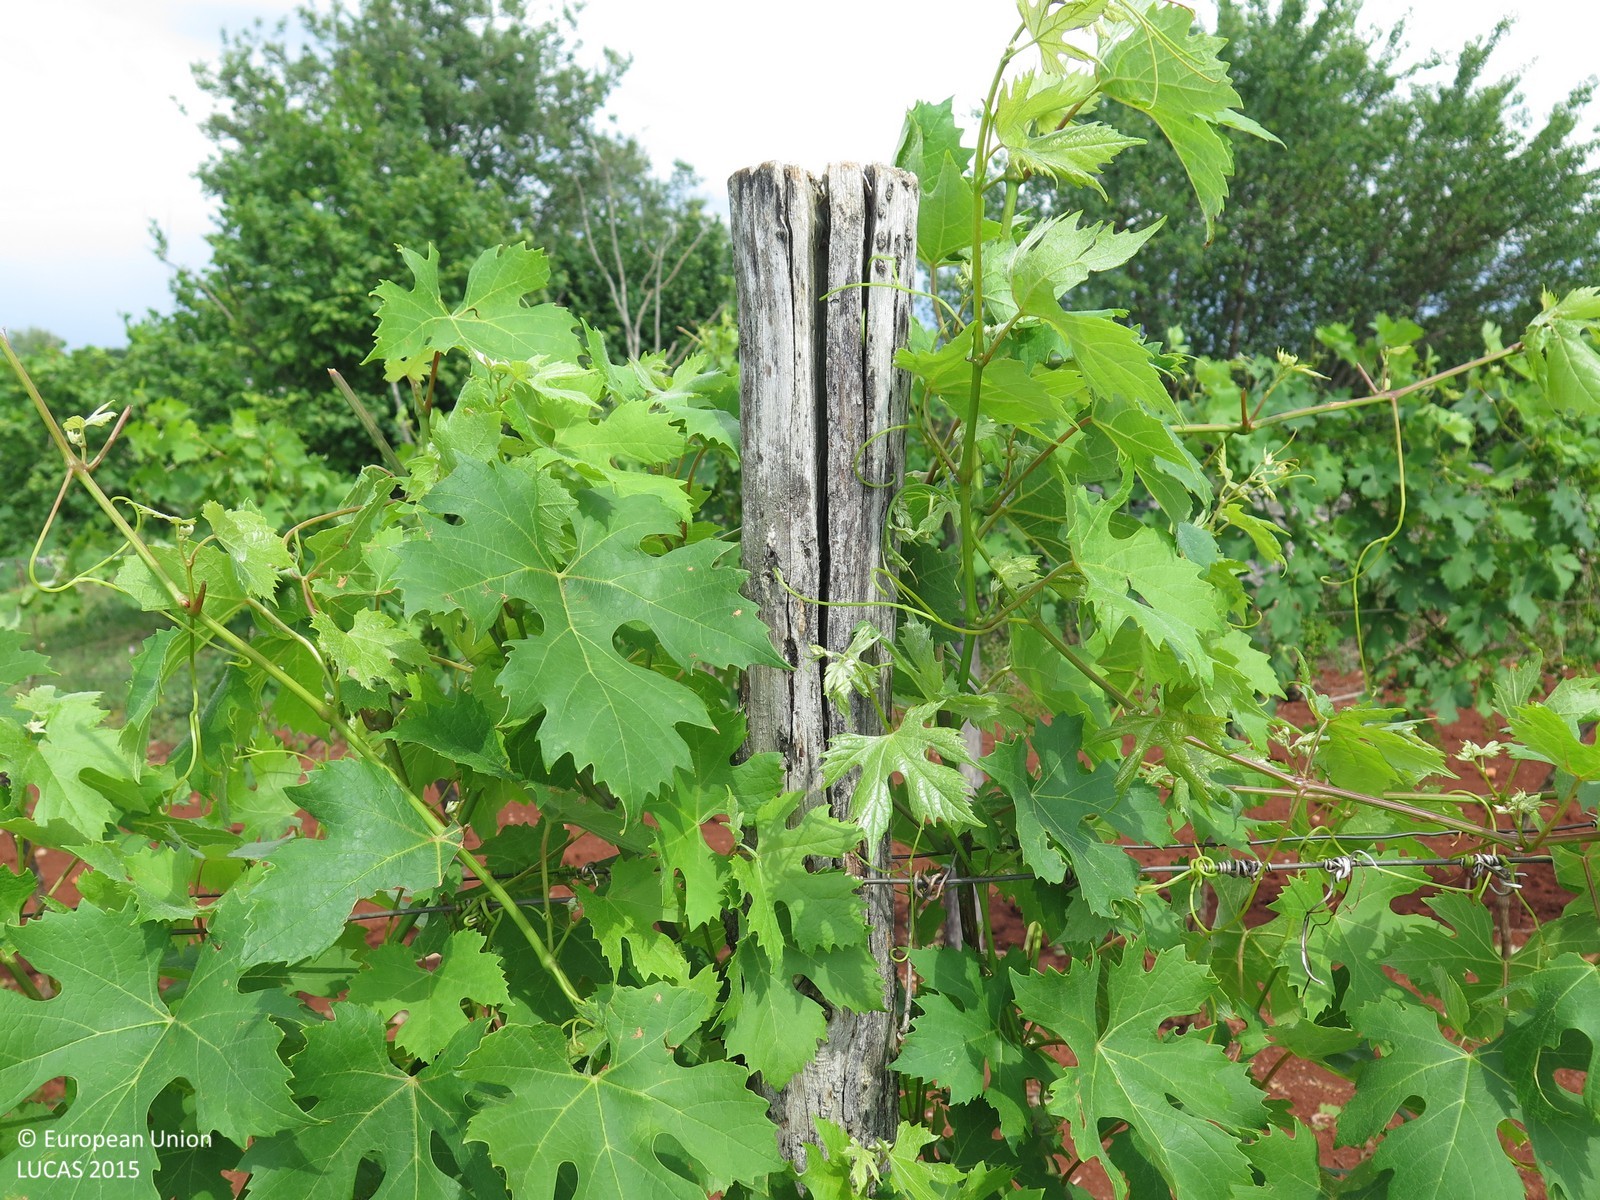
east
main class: Cropland
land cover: Vineyards
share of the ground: > 75 %
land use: Agriculture (excluding fallow land and kitchen gardens)
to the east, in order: Vineyards; Dry stone walls; Abandoned hedges; Lucerne; Grass margins; Shrubland with sparse tree cover; Dry stone walls; Abandoned hedges; Other bare soil; Grassland without tree/shrub cover; Abandoned hedges; Dry stone walls; Mixed cereals for fodder
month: June
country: HR
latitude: 45.2564
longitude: 13.7795
